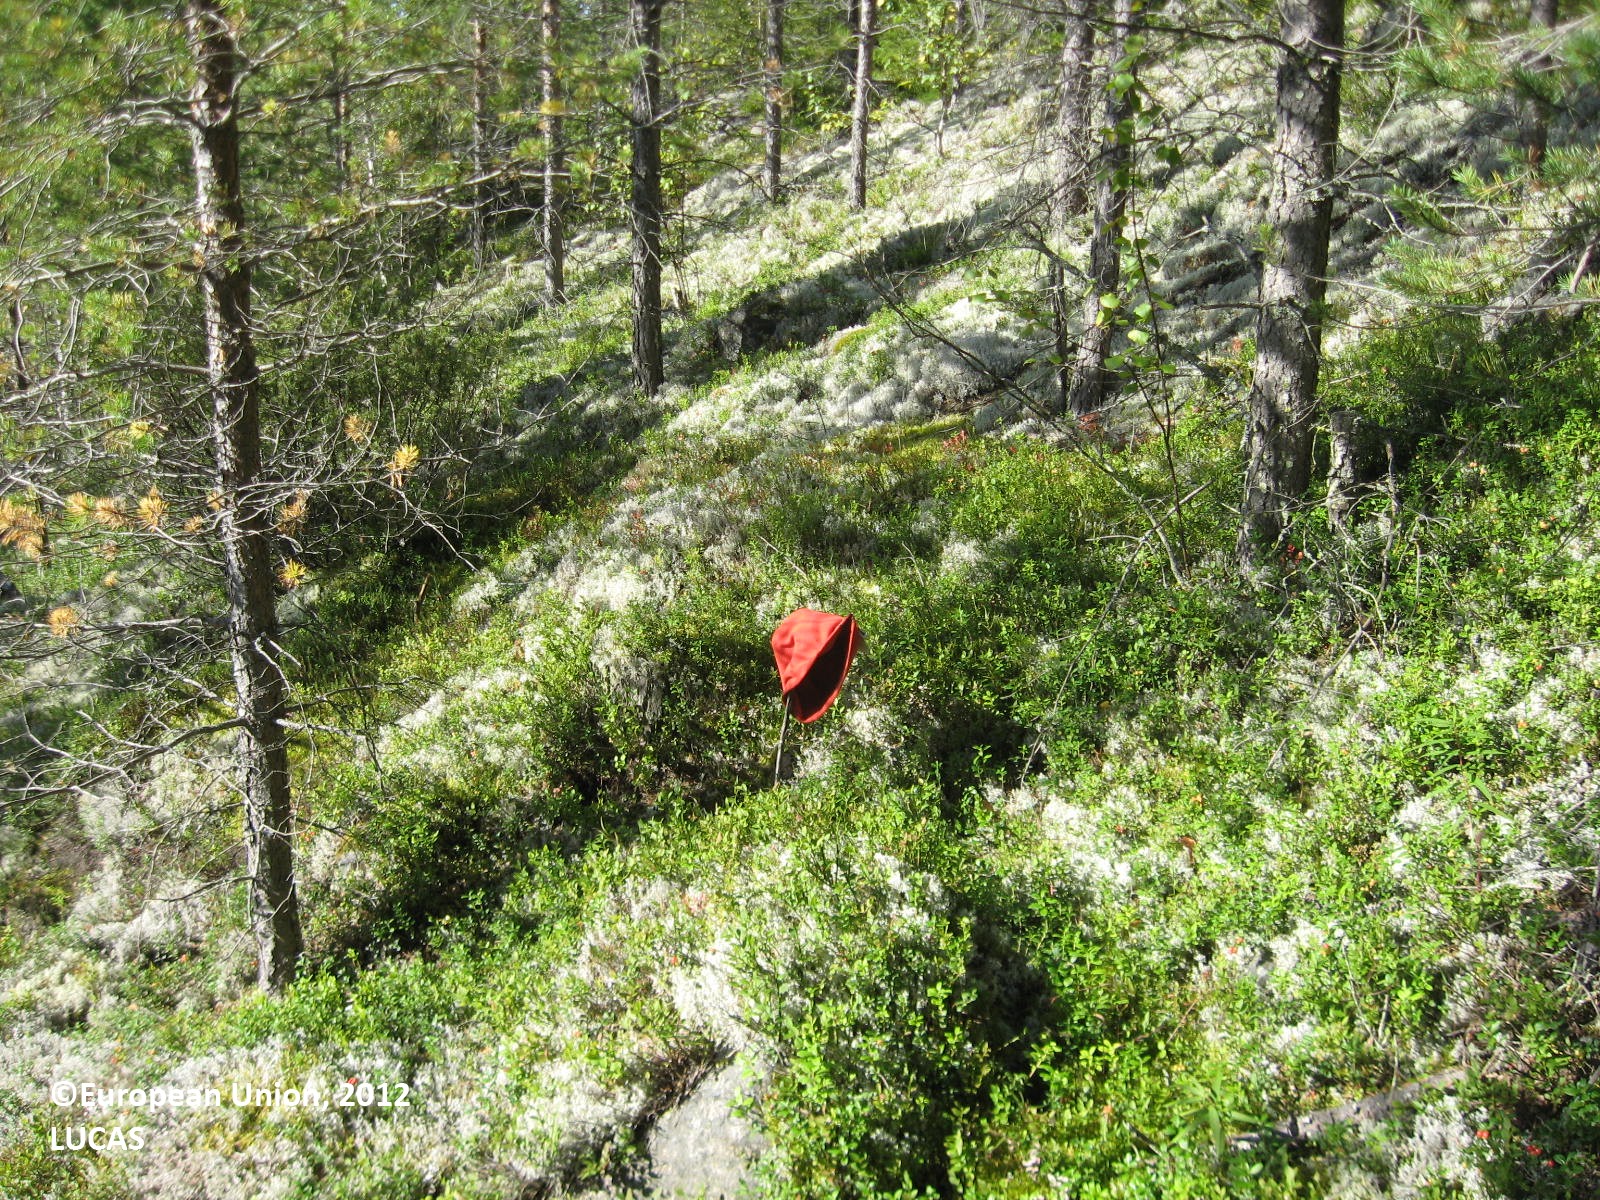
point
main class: Woodland
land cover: Pine dominated coniferous woodland
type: boreal forest
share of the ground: > 75 %
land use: Forestry
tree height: > 5 m
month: August
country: FI
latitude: 63.6798
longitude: 29.7420
